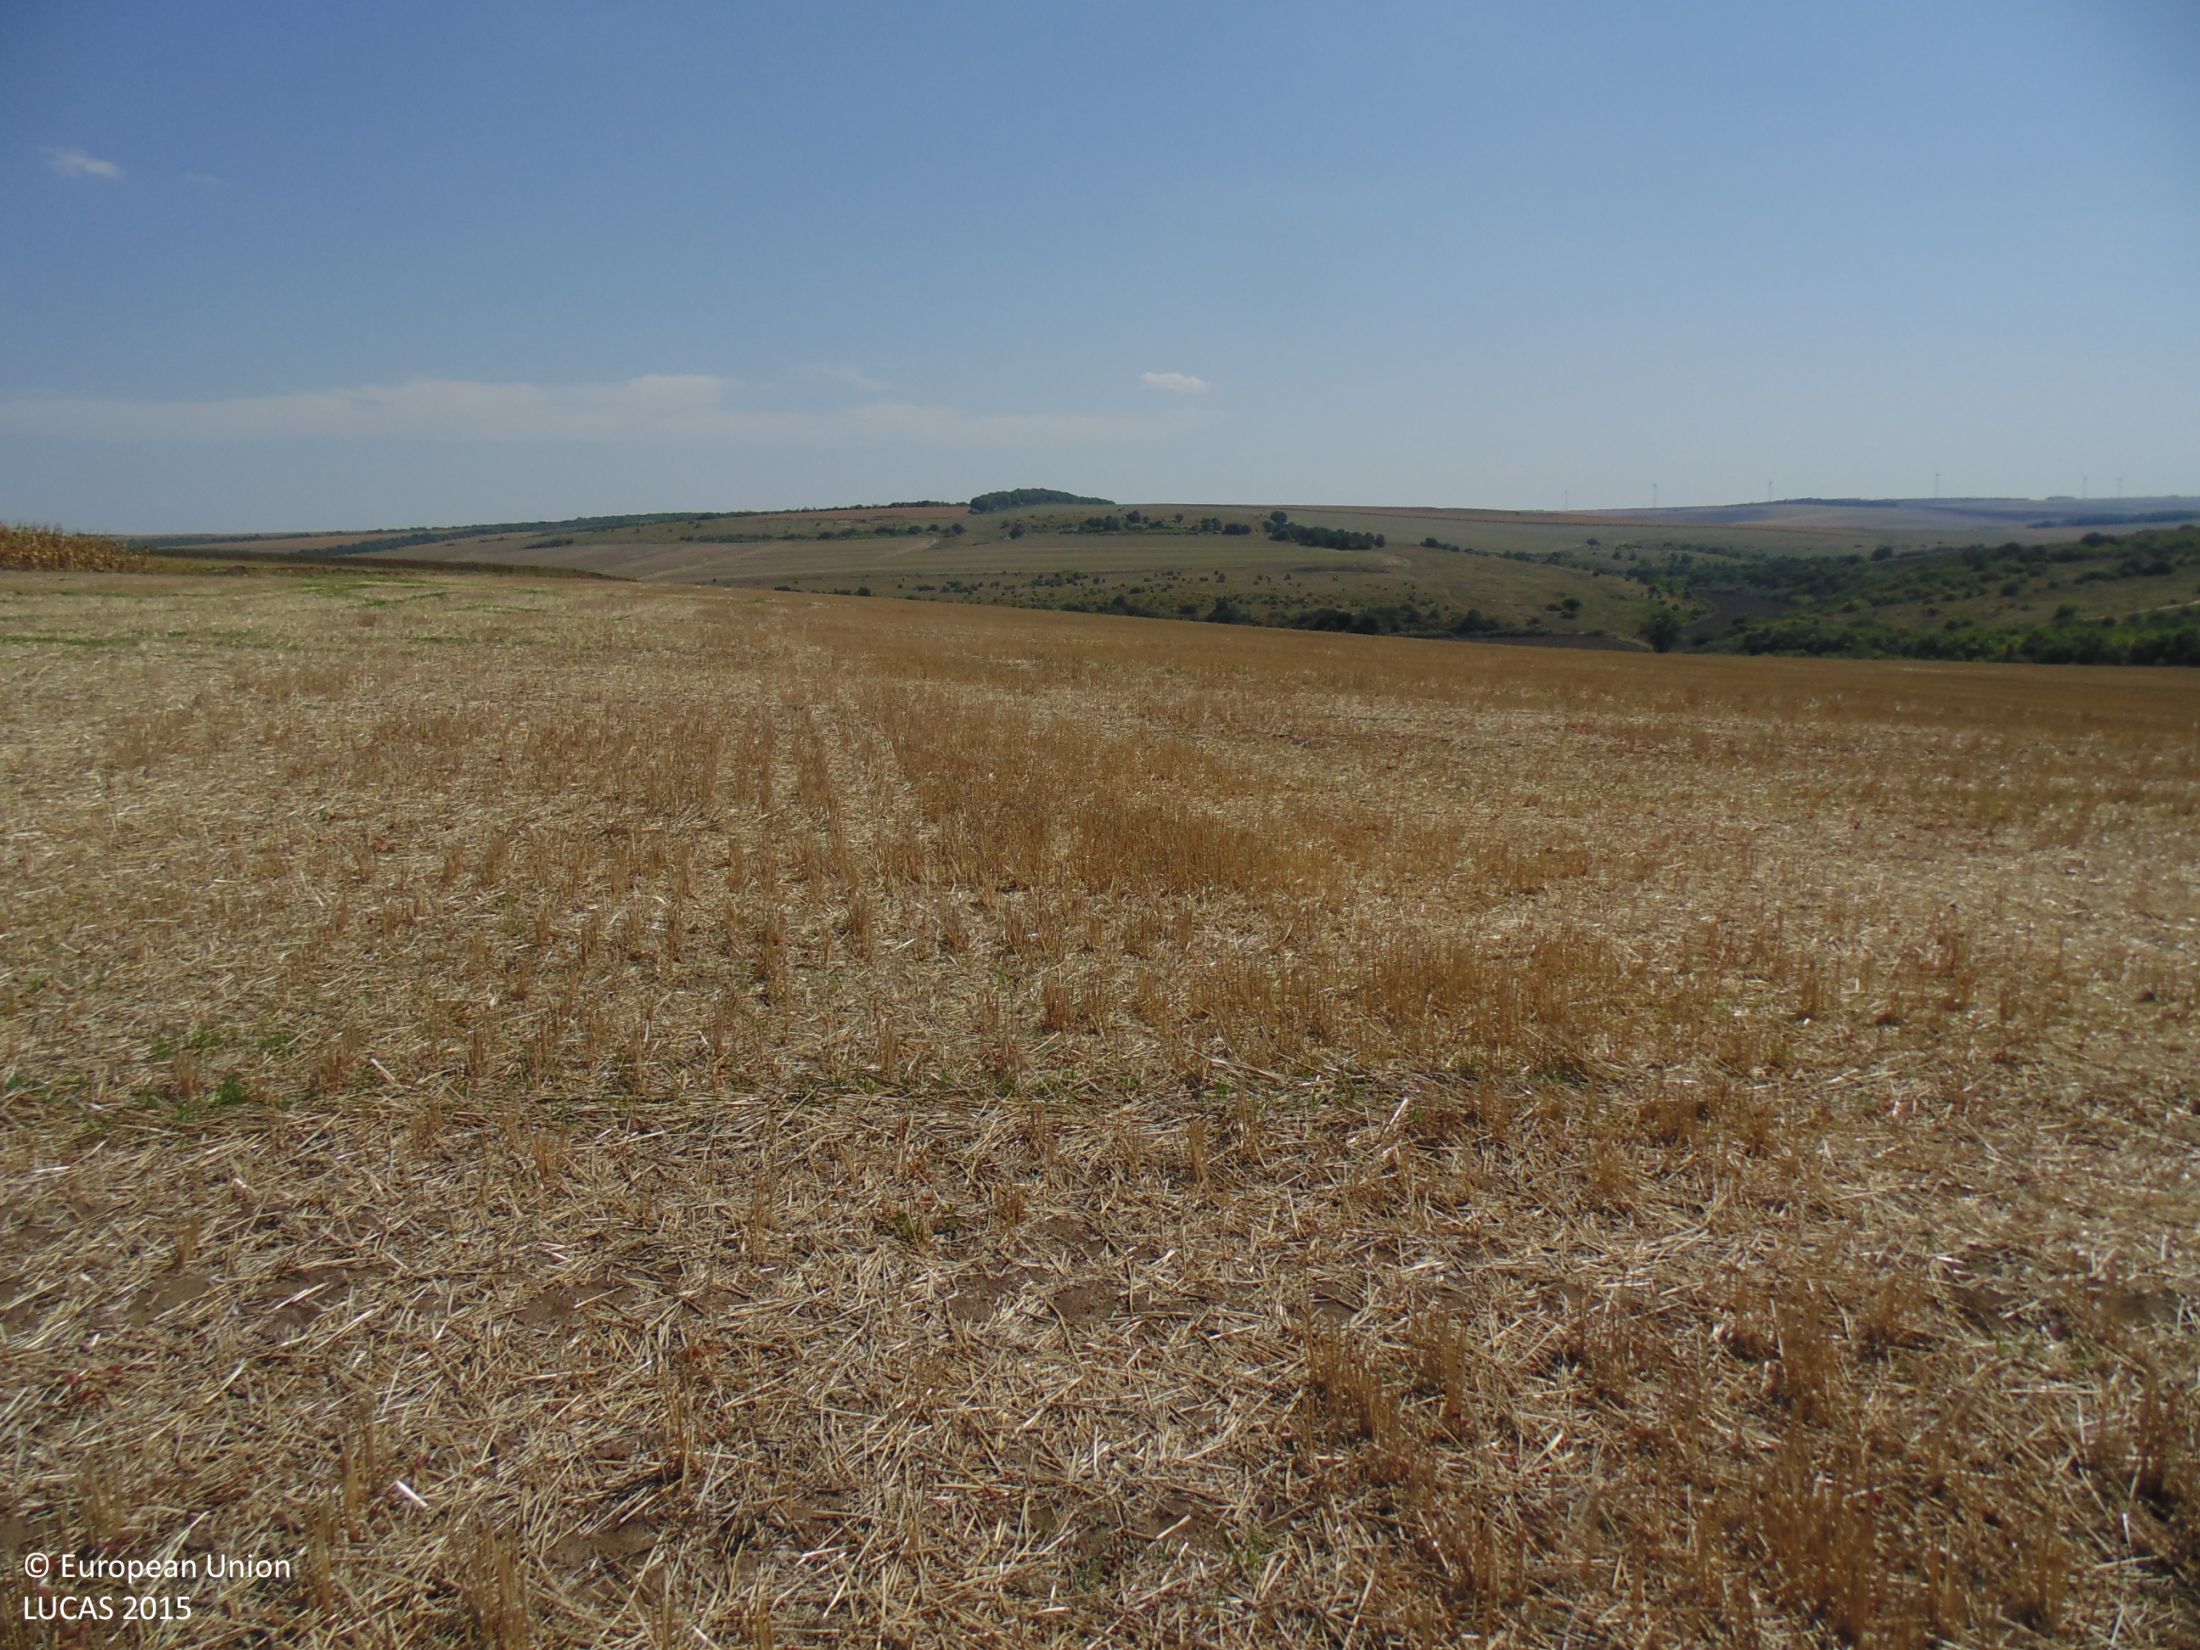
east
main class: Cropland
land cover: Common wheat
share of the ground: 25 - 50 %
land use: Agriculture (excluding fallow land and kitchen gardens)
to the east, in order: Common wheat
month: August
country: BG
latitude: 43.6672
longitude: 27.4572
